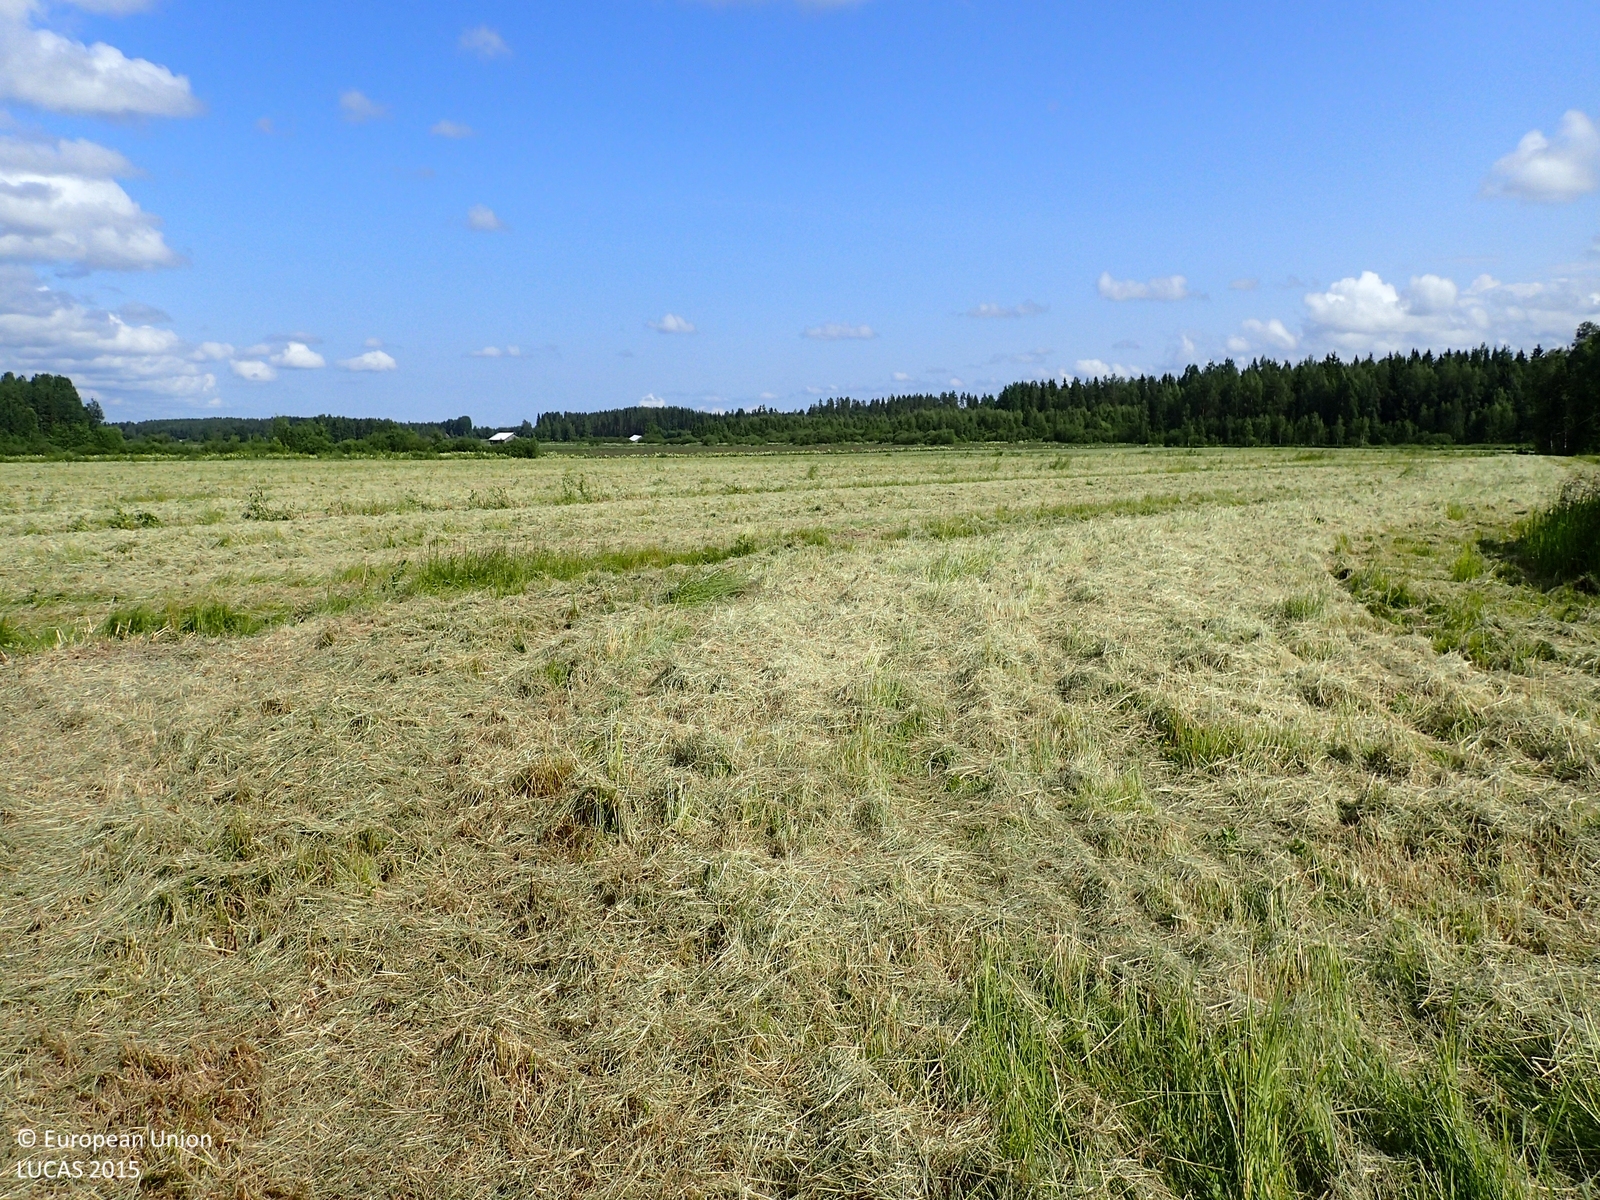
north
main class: Cropland
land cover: Temporary grasslands
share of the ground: > 75 %
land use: Agriculture (excluding fallow land and kitchen gardens)
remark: Harvested field
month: July
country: FI
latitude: 62.7585
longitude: 23.6416
